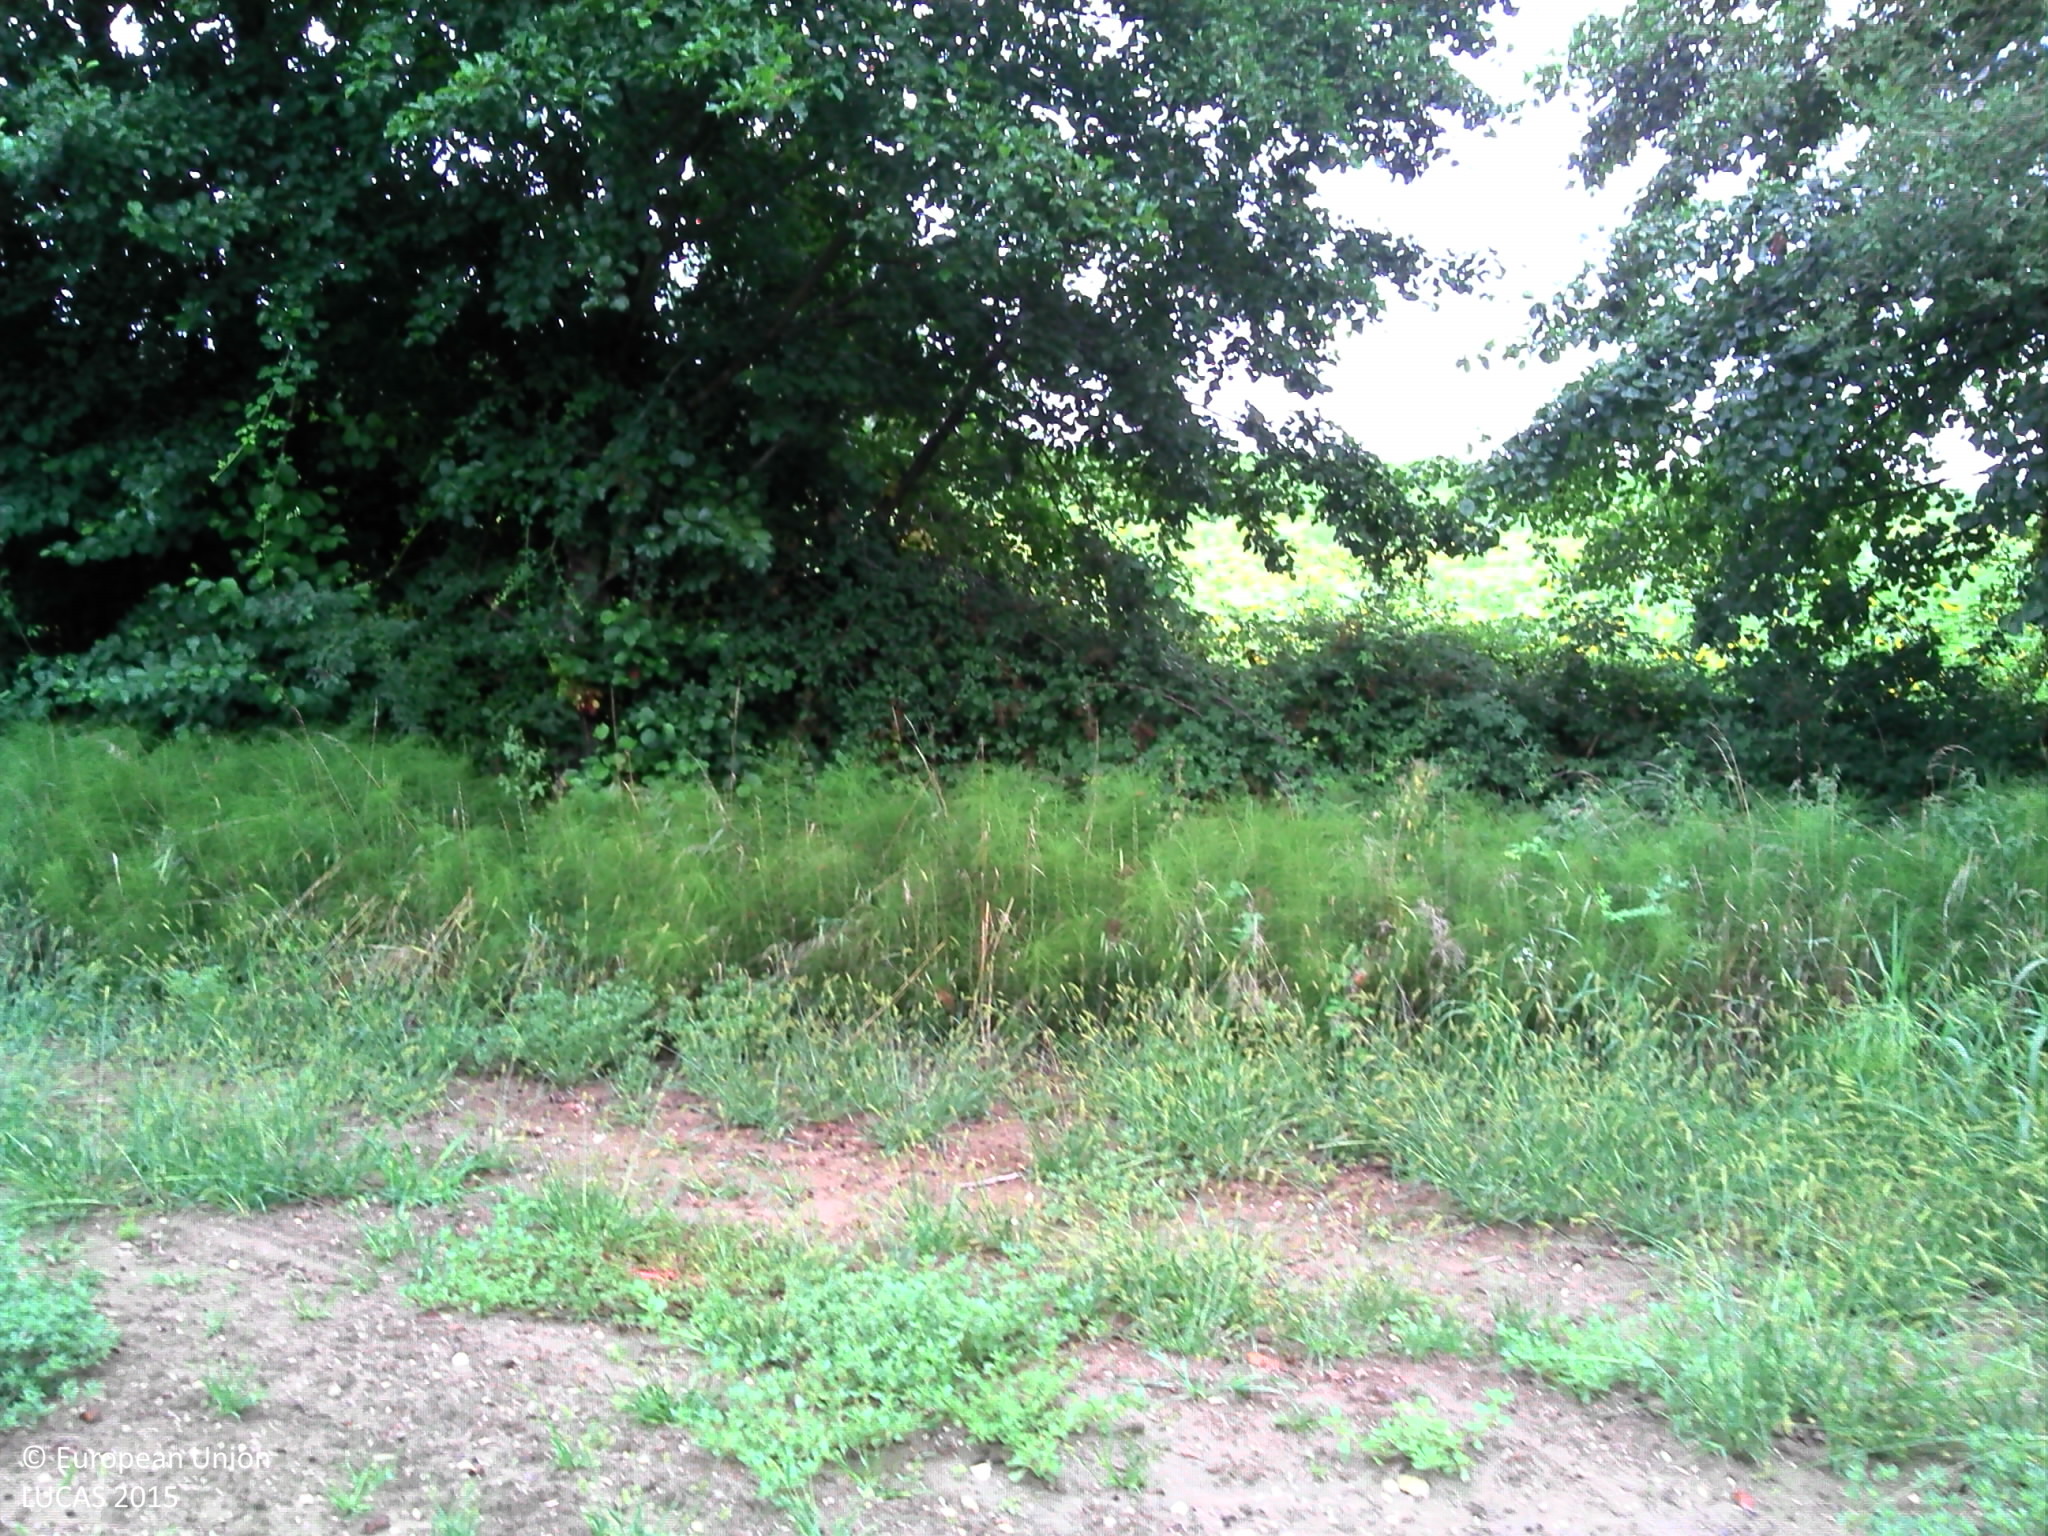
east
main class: Cropland
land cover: Maize
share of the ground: > 75 %
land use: Agriculture (excluding fallow land and kitchen gardens)
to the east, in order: Maize; Abandoned hedges; Sunflower; Ditches and canals; Durum wheat
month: August
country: FR
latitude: 44.0040
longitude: 1.5326
